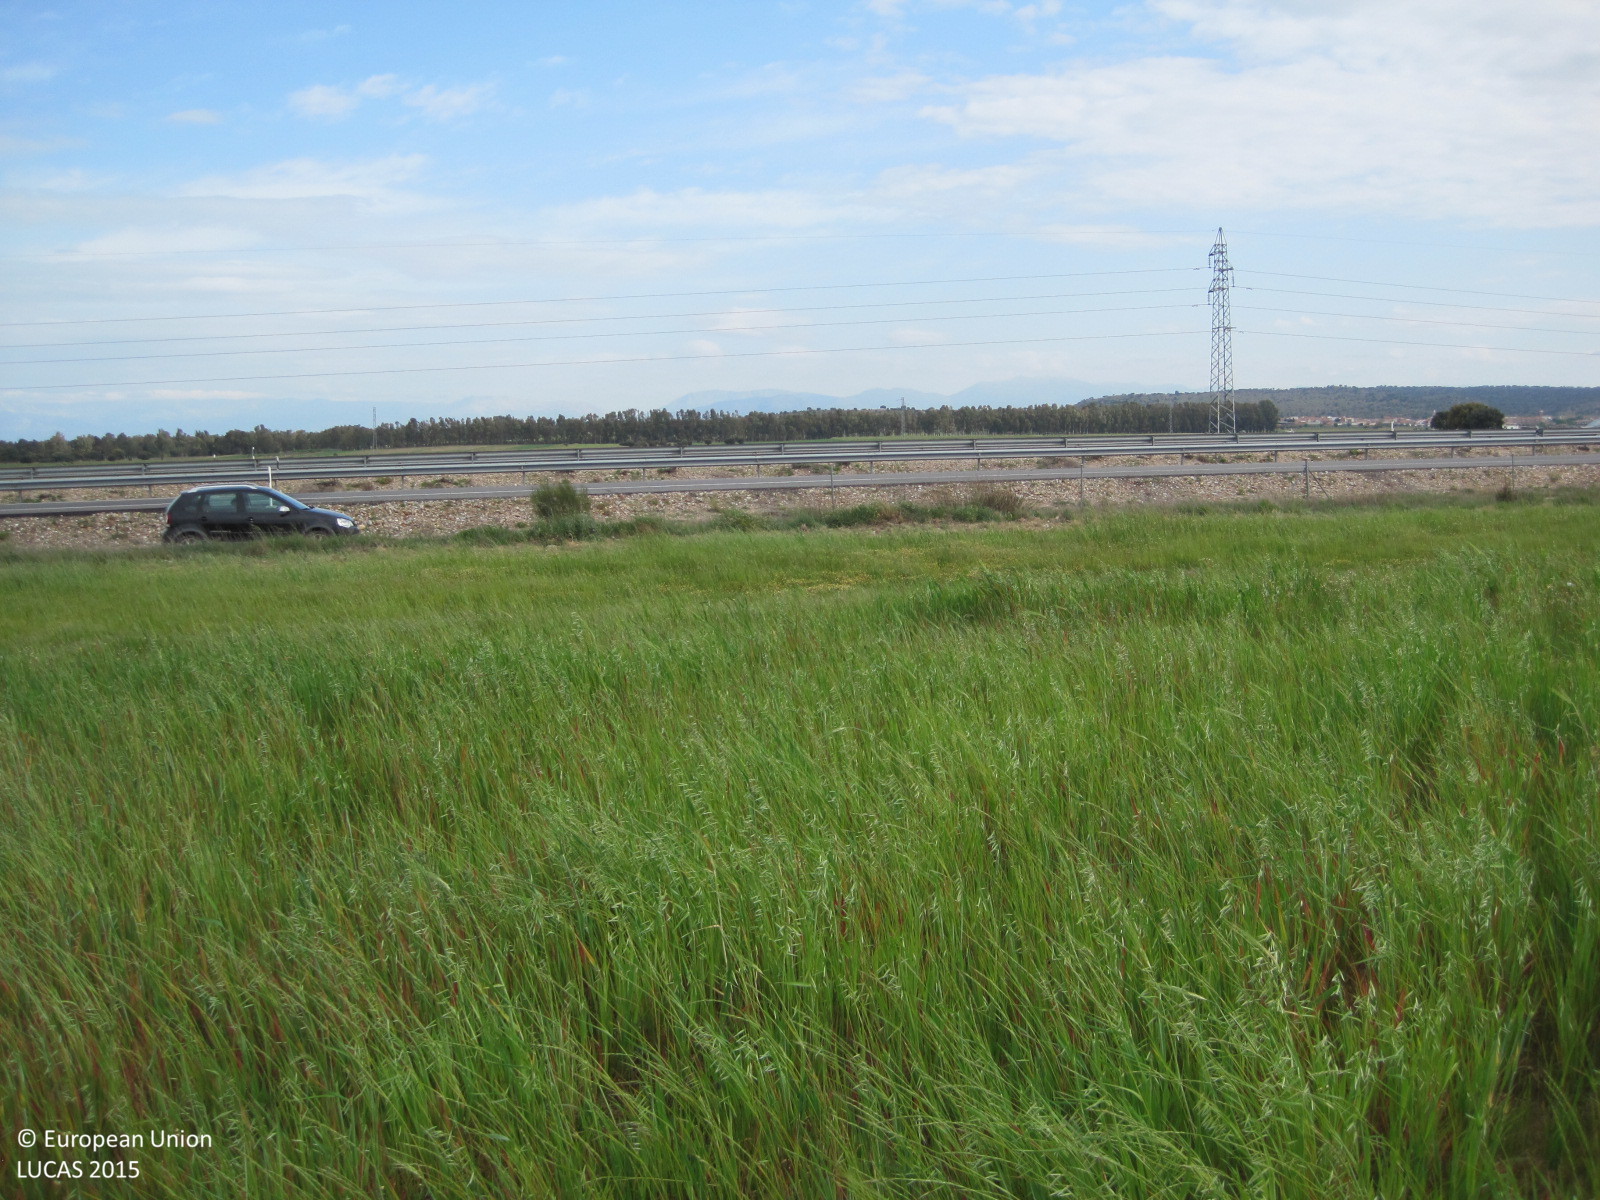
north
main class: Cropland
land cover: Mixed cereals for fodder
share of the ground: > 75 %
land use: Agriculture (excluding fallow land and kitchen gardens)
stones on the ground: 25 - 50 %
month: April
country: ES
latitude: 39.9378
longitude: -4.9706
